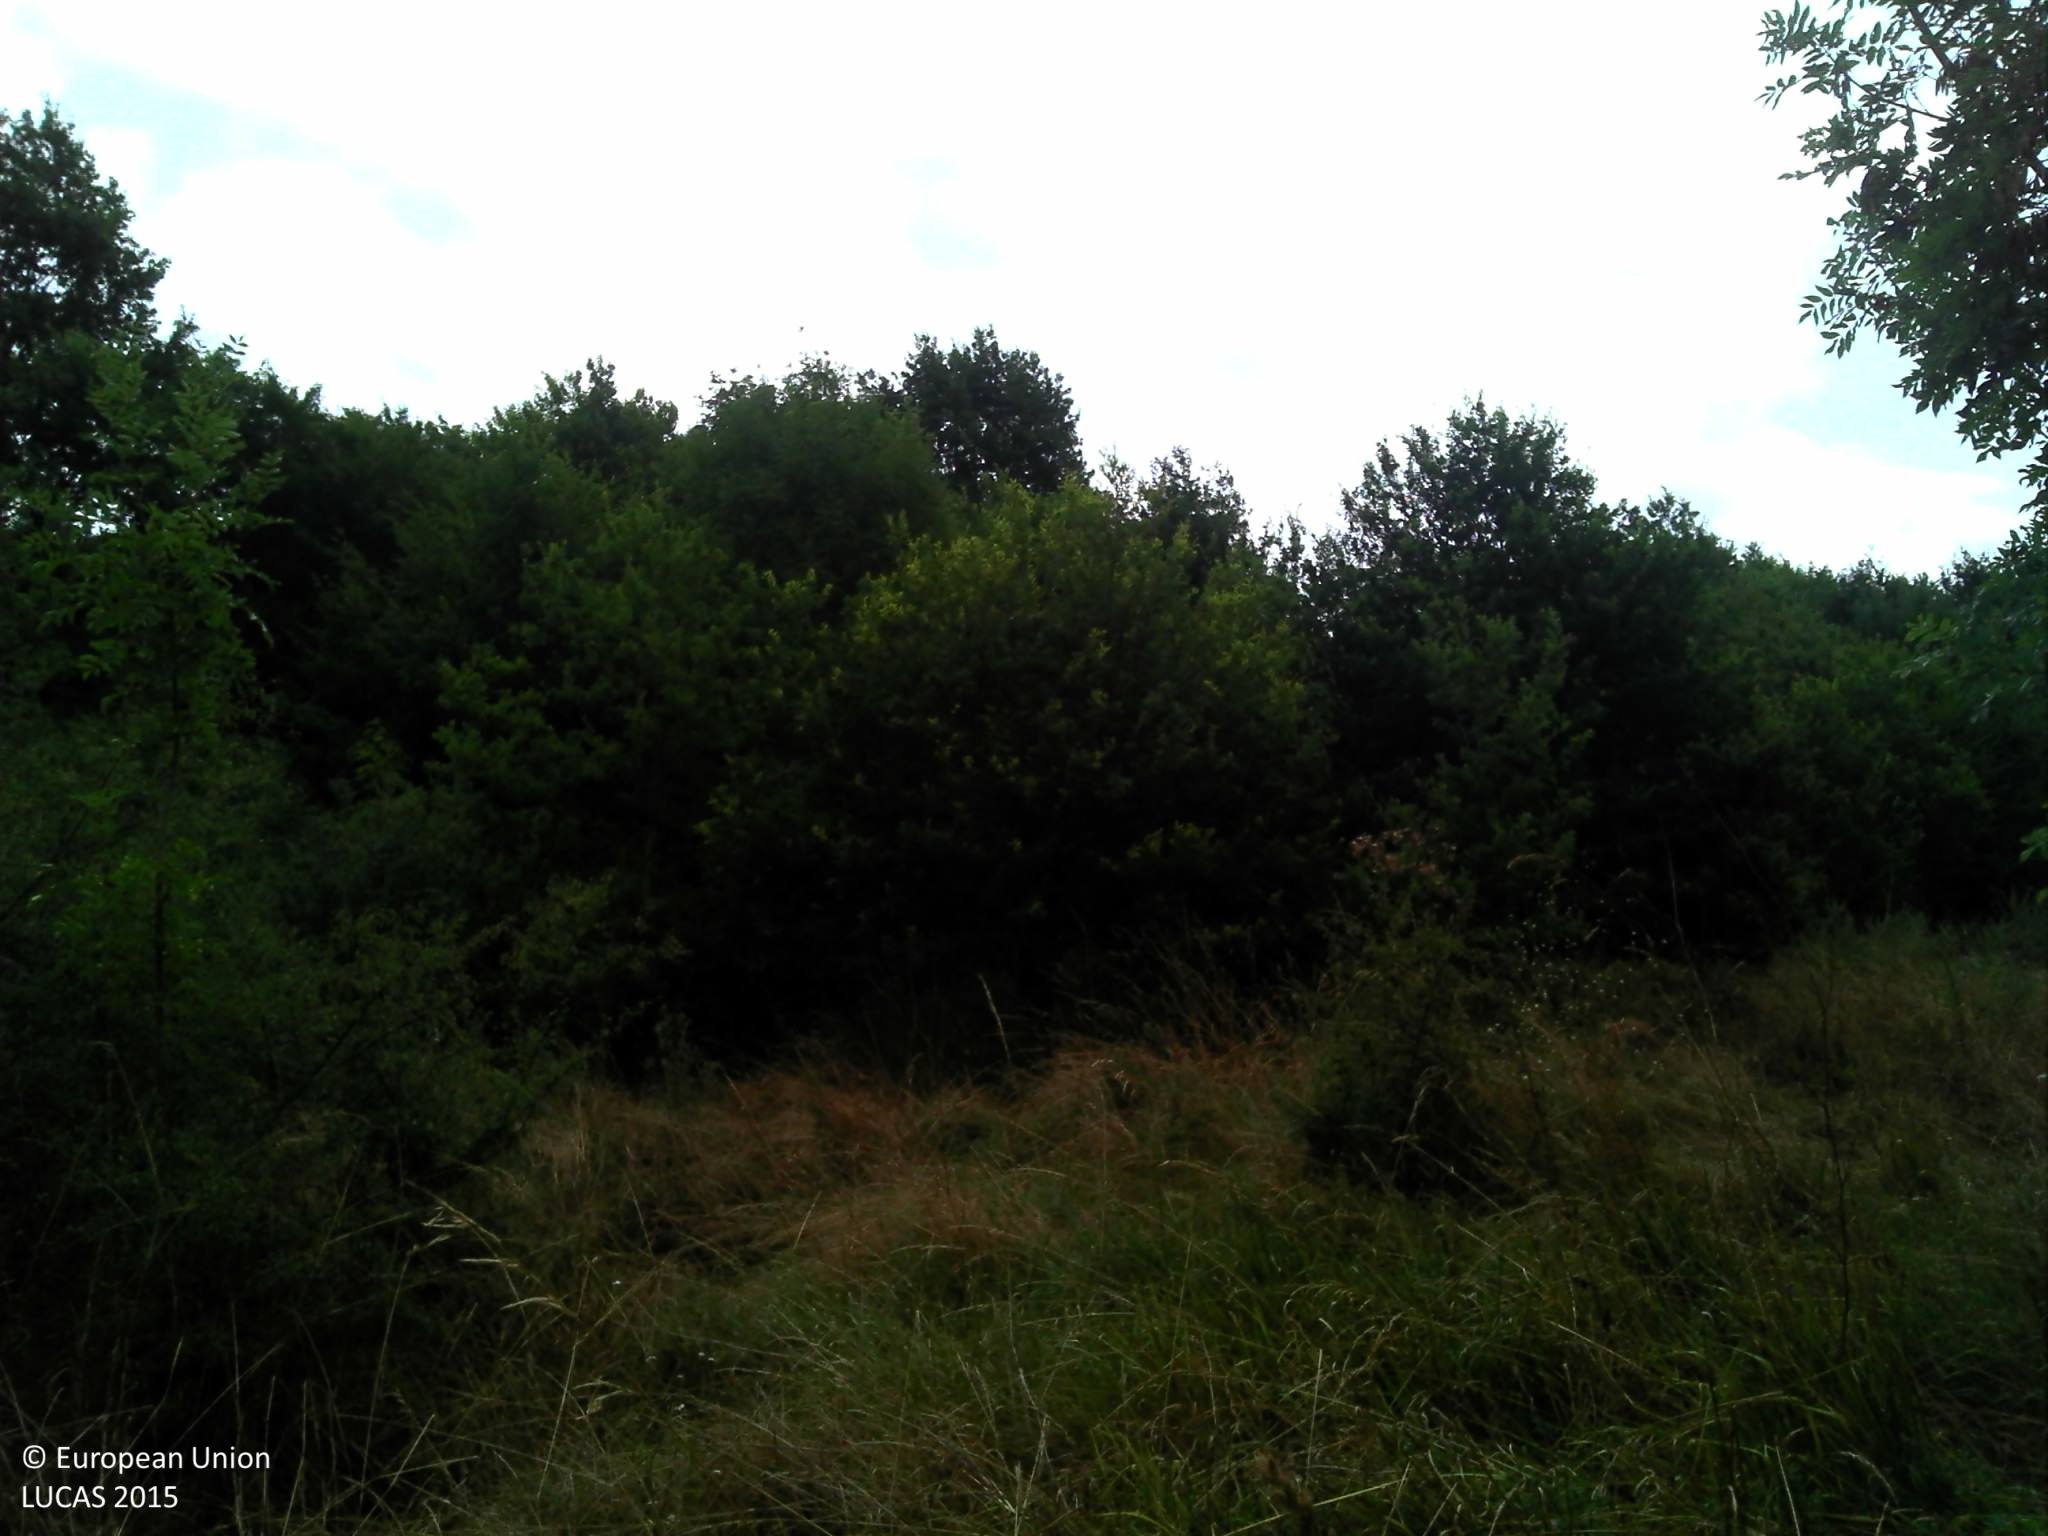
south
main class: Grassland
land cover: Grassland with sparse tree/shrub cover
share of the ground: > 75 %
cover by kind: herbaceous plants 80 %, shrubs 10 %, broadleaved forest trees 5 %, lichens and mosses 5 %
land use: Semi-natural and natural areas not in use
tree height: > 5 m
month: July
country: FR
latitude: 45.5756
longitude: 0.6199
